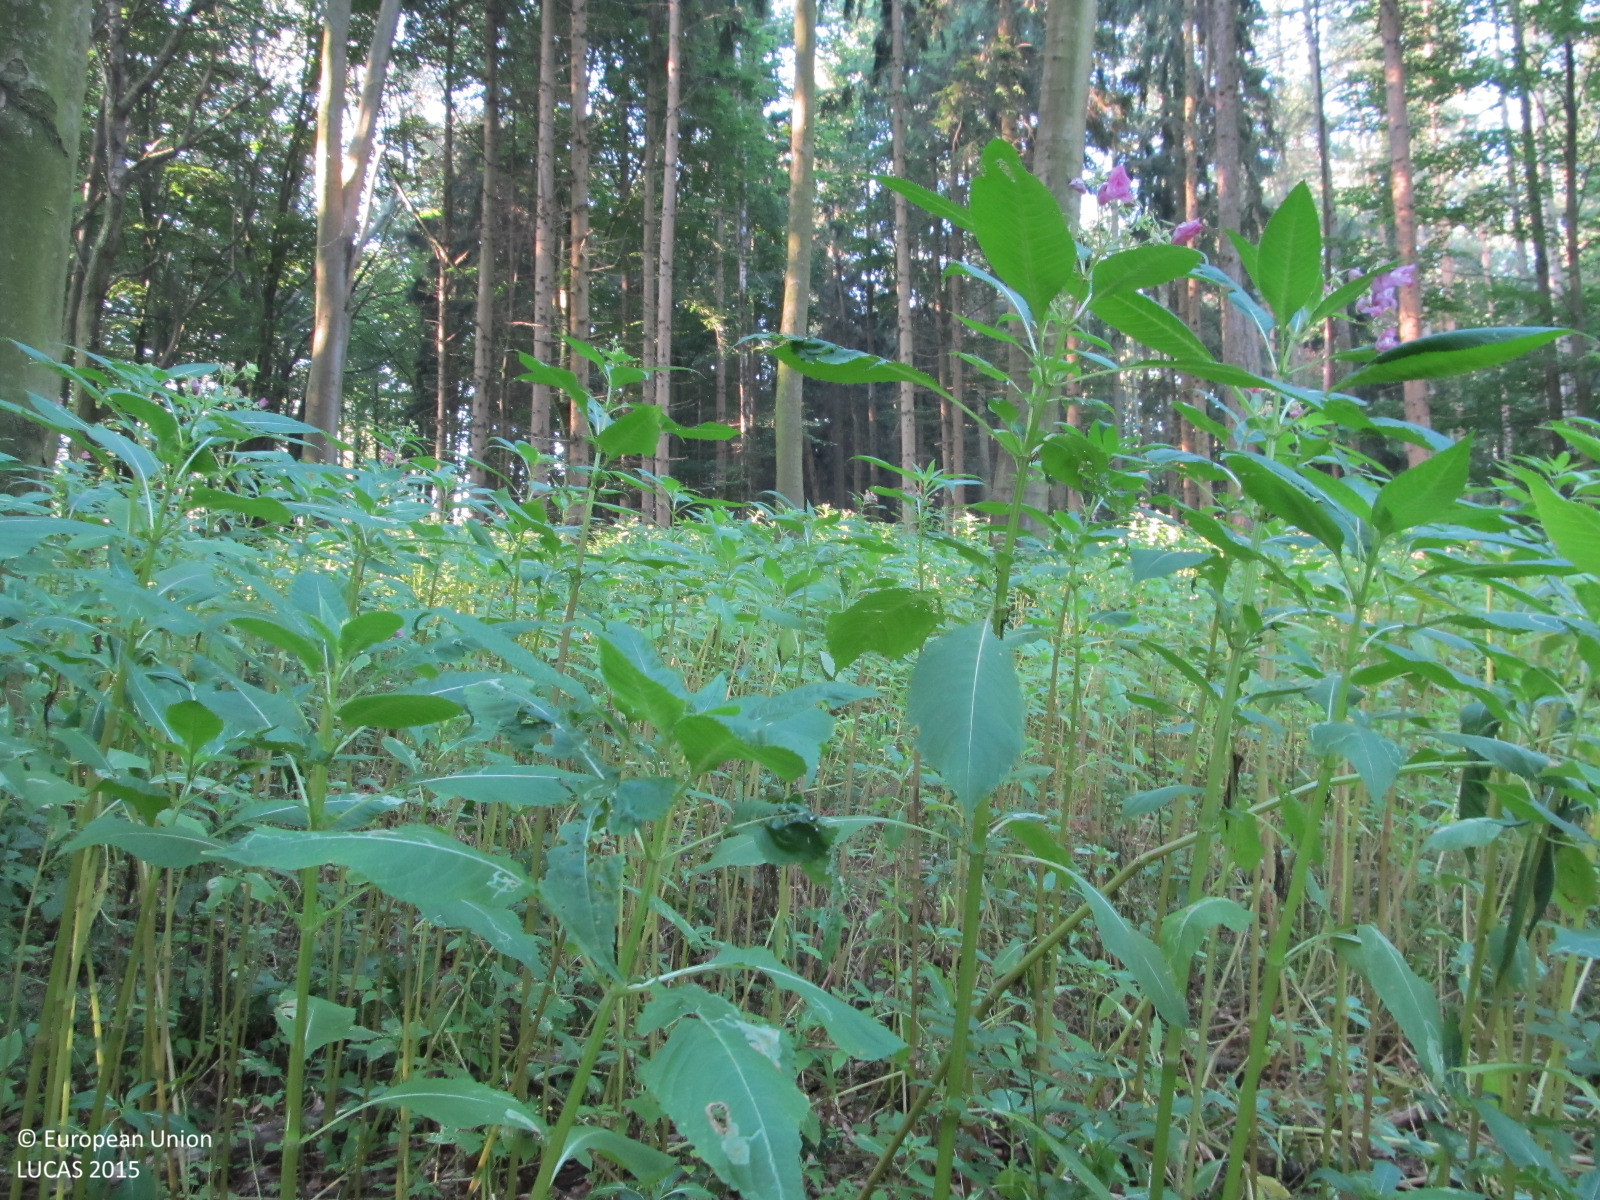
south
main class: Woodland
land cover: Spruce dominated mixed woodland
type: hemiboreal forest and nemoral coniferous forest and mixed broadleaved-coniferous forest
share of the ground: 50 - 75 %
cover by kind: coniferous forest trees 35 %, broadleaved forest trees 35 %, herbaceous plants 20 %, shrubs 10 %
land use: Forestry
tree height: > 5 m
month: August
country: AT
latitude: 48.2315
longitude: 15.8327
